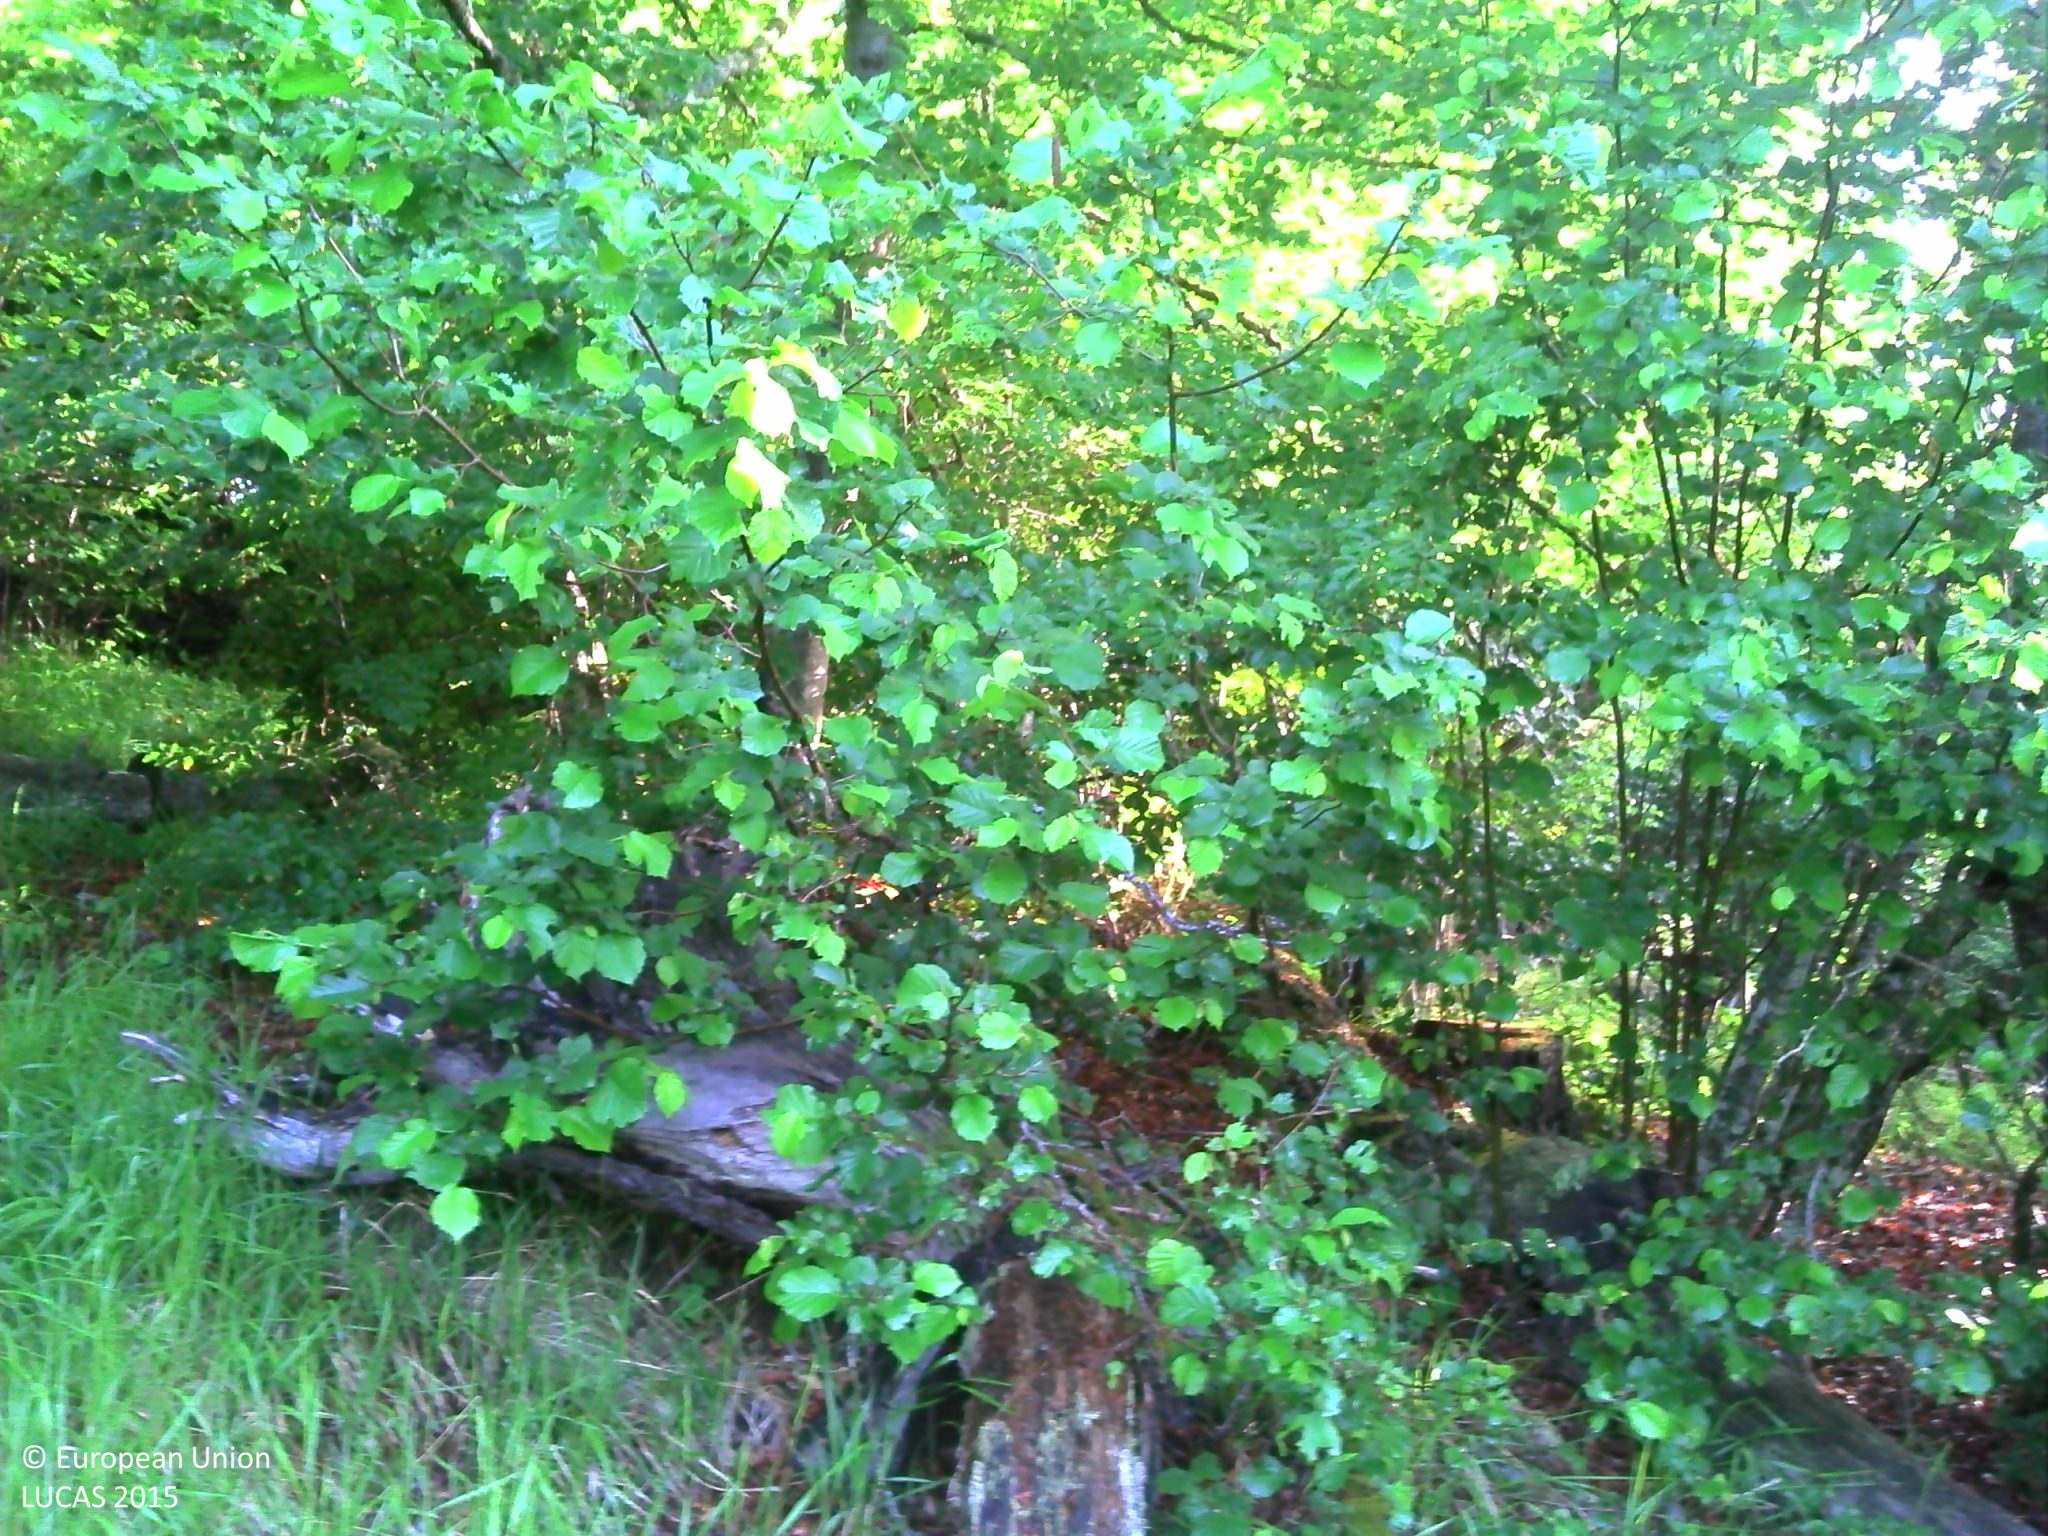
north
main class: Woodland
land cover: Pine dominated mixed woodland
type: alpine coniferous forest
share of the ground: > 75 %
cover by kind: broadleaved forest trees 50 %, coniferous forest trees 20 %, herbaceous plants 20 %, shrubs 10 %
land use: Forestry
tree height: > 5 m
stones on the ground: 10 - 25 %
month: June
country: FR
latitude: 45.1757
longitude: 2.9135
